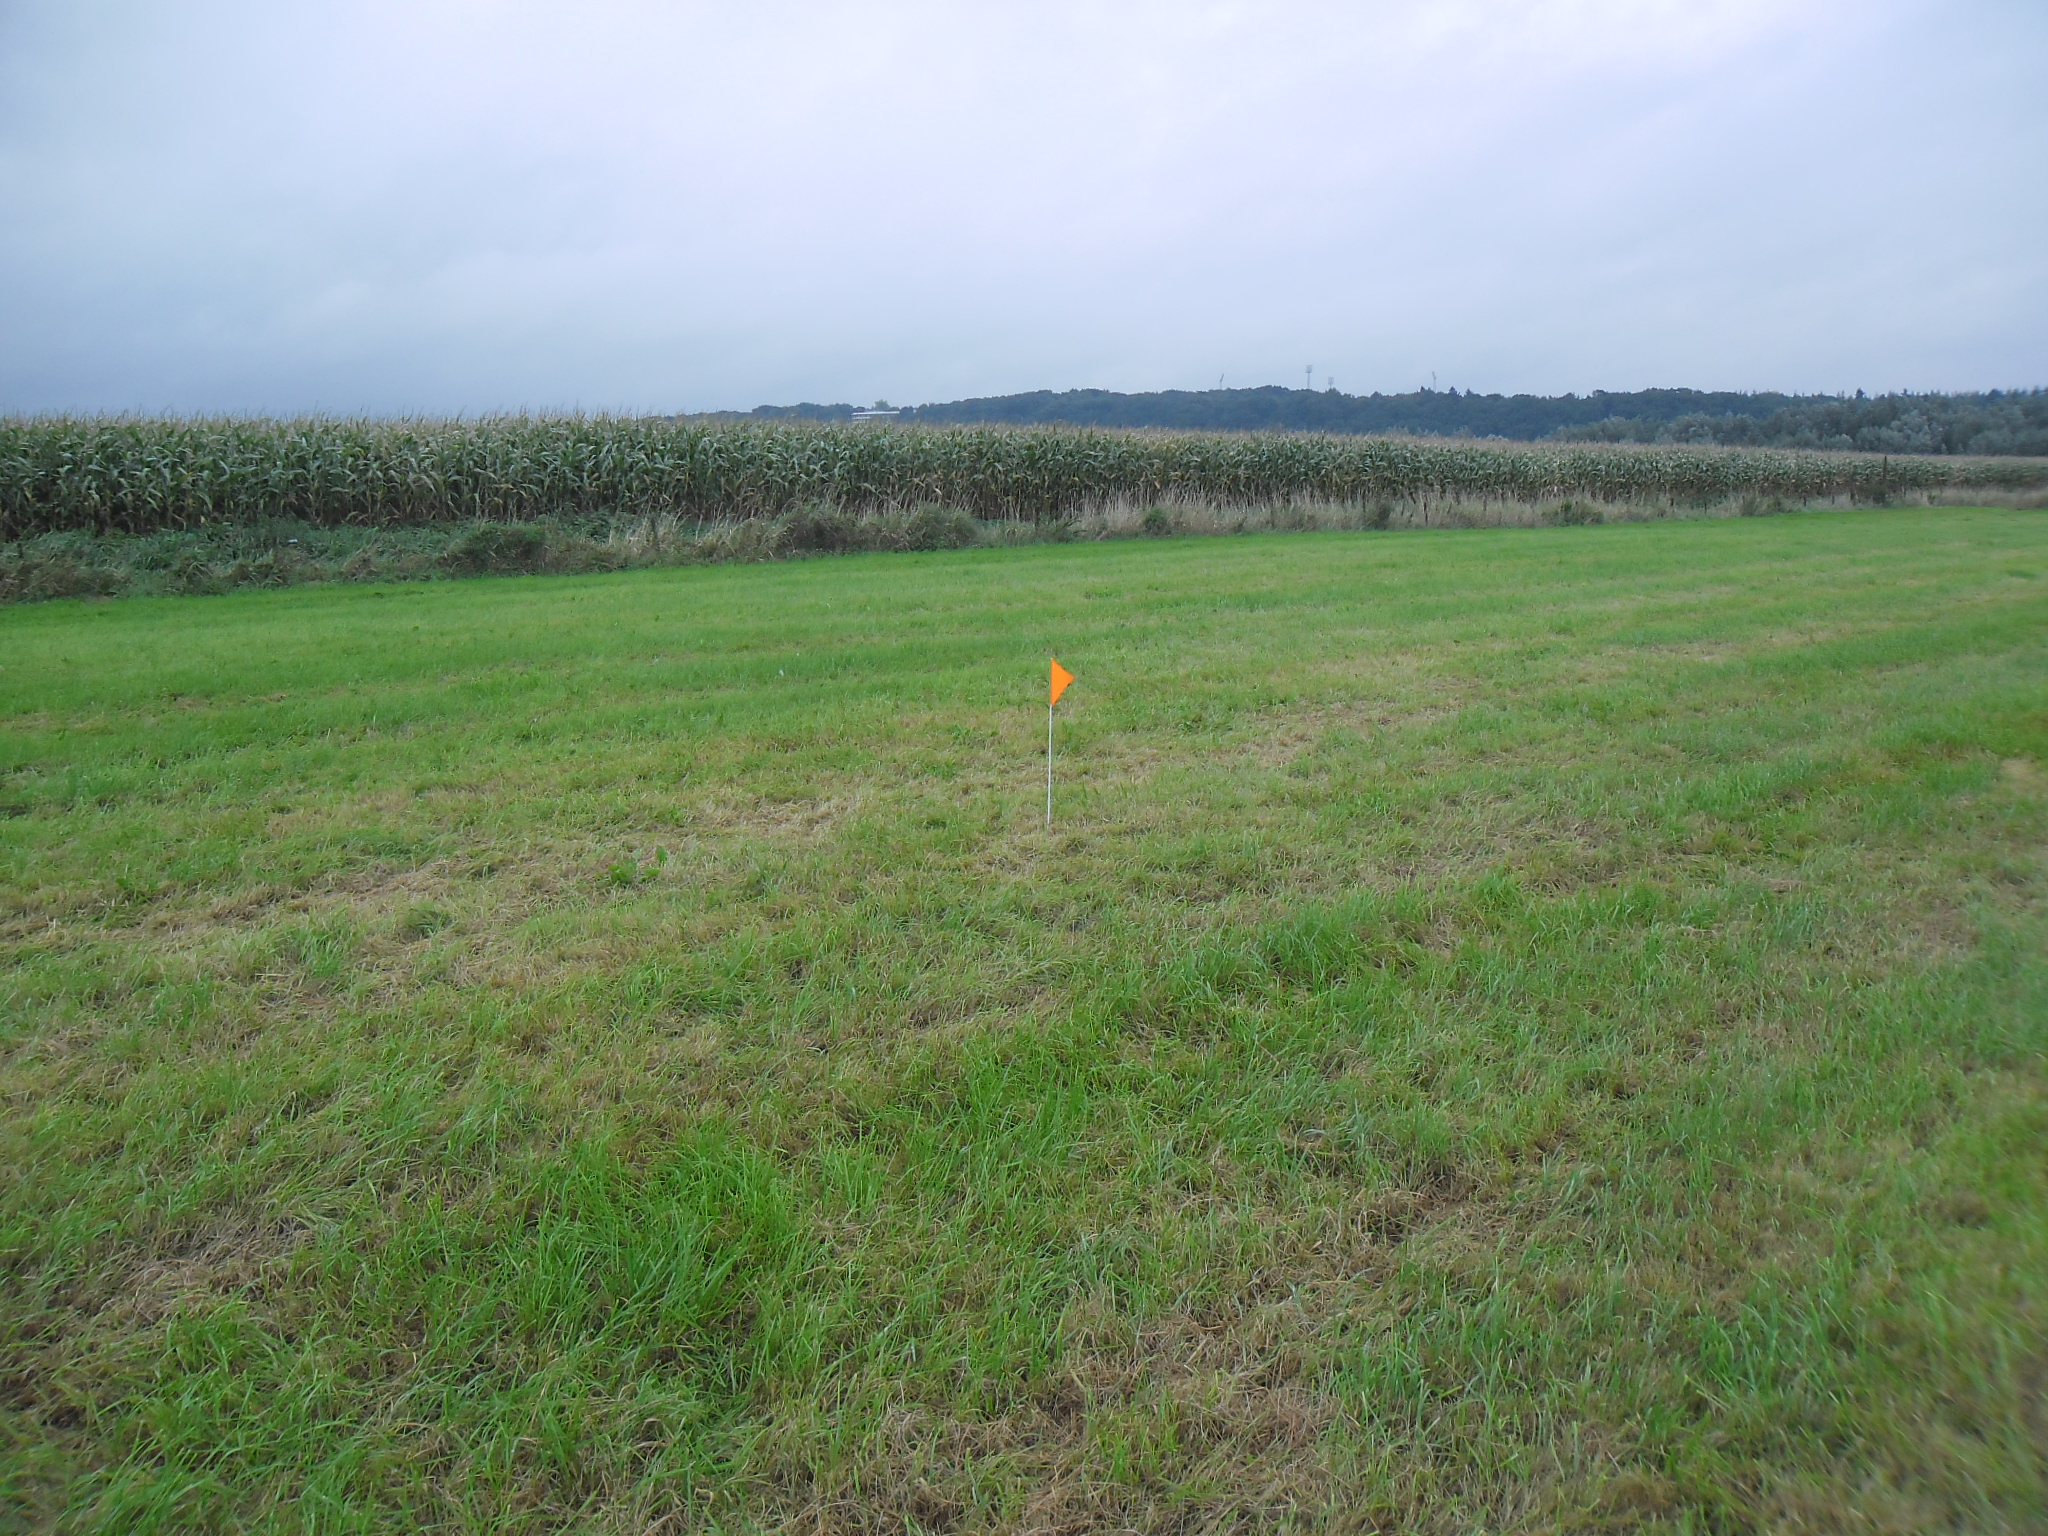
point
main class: Grassland
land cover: Grassland without tree/shrub cover
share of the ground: > 75 %
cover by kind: herbaceous plants 100 %
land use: Agriculture (excluding fallow land and kitchen gardens)
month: September
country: NL
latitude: 51.9578
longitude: 5.7058
